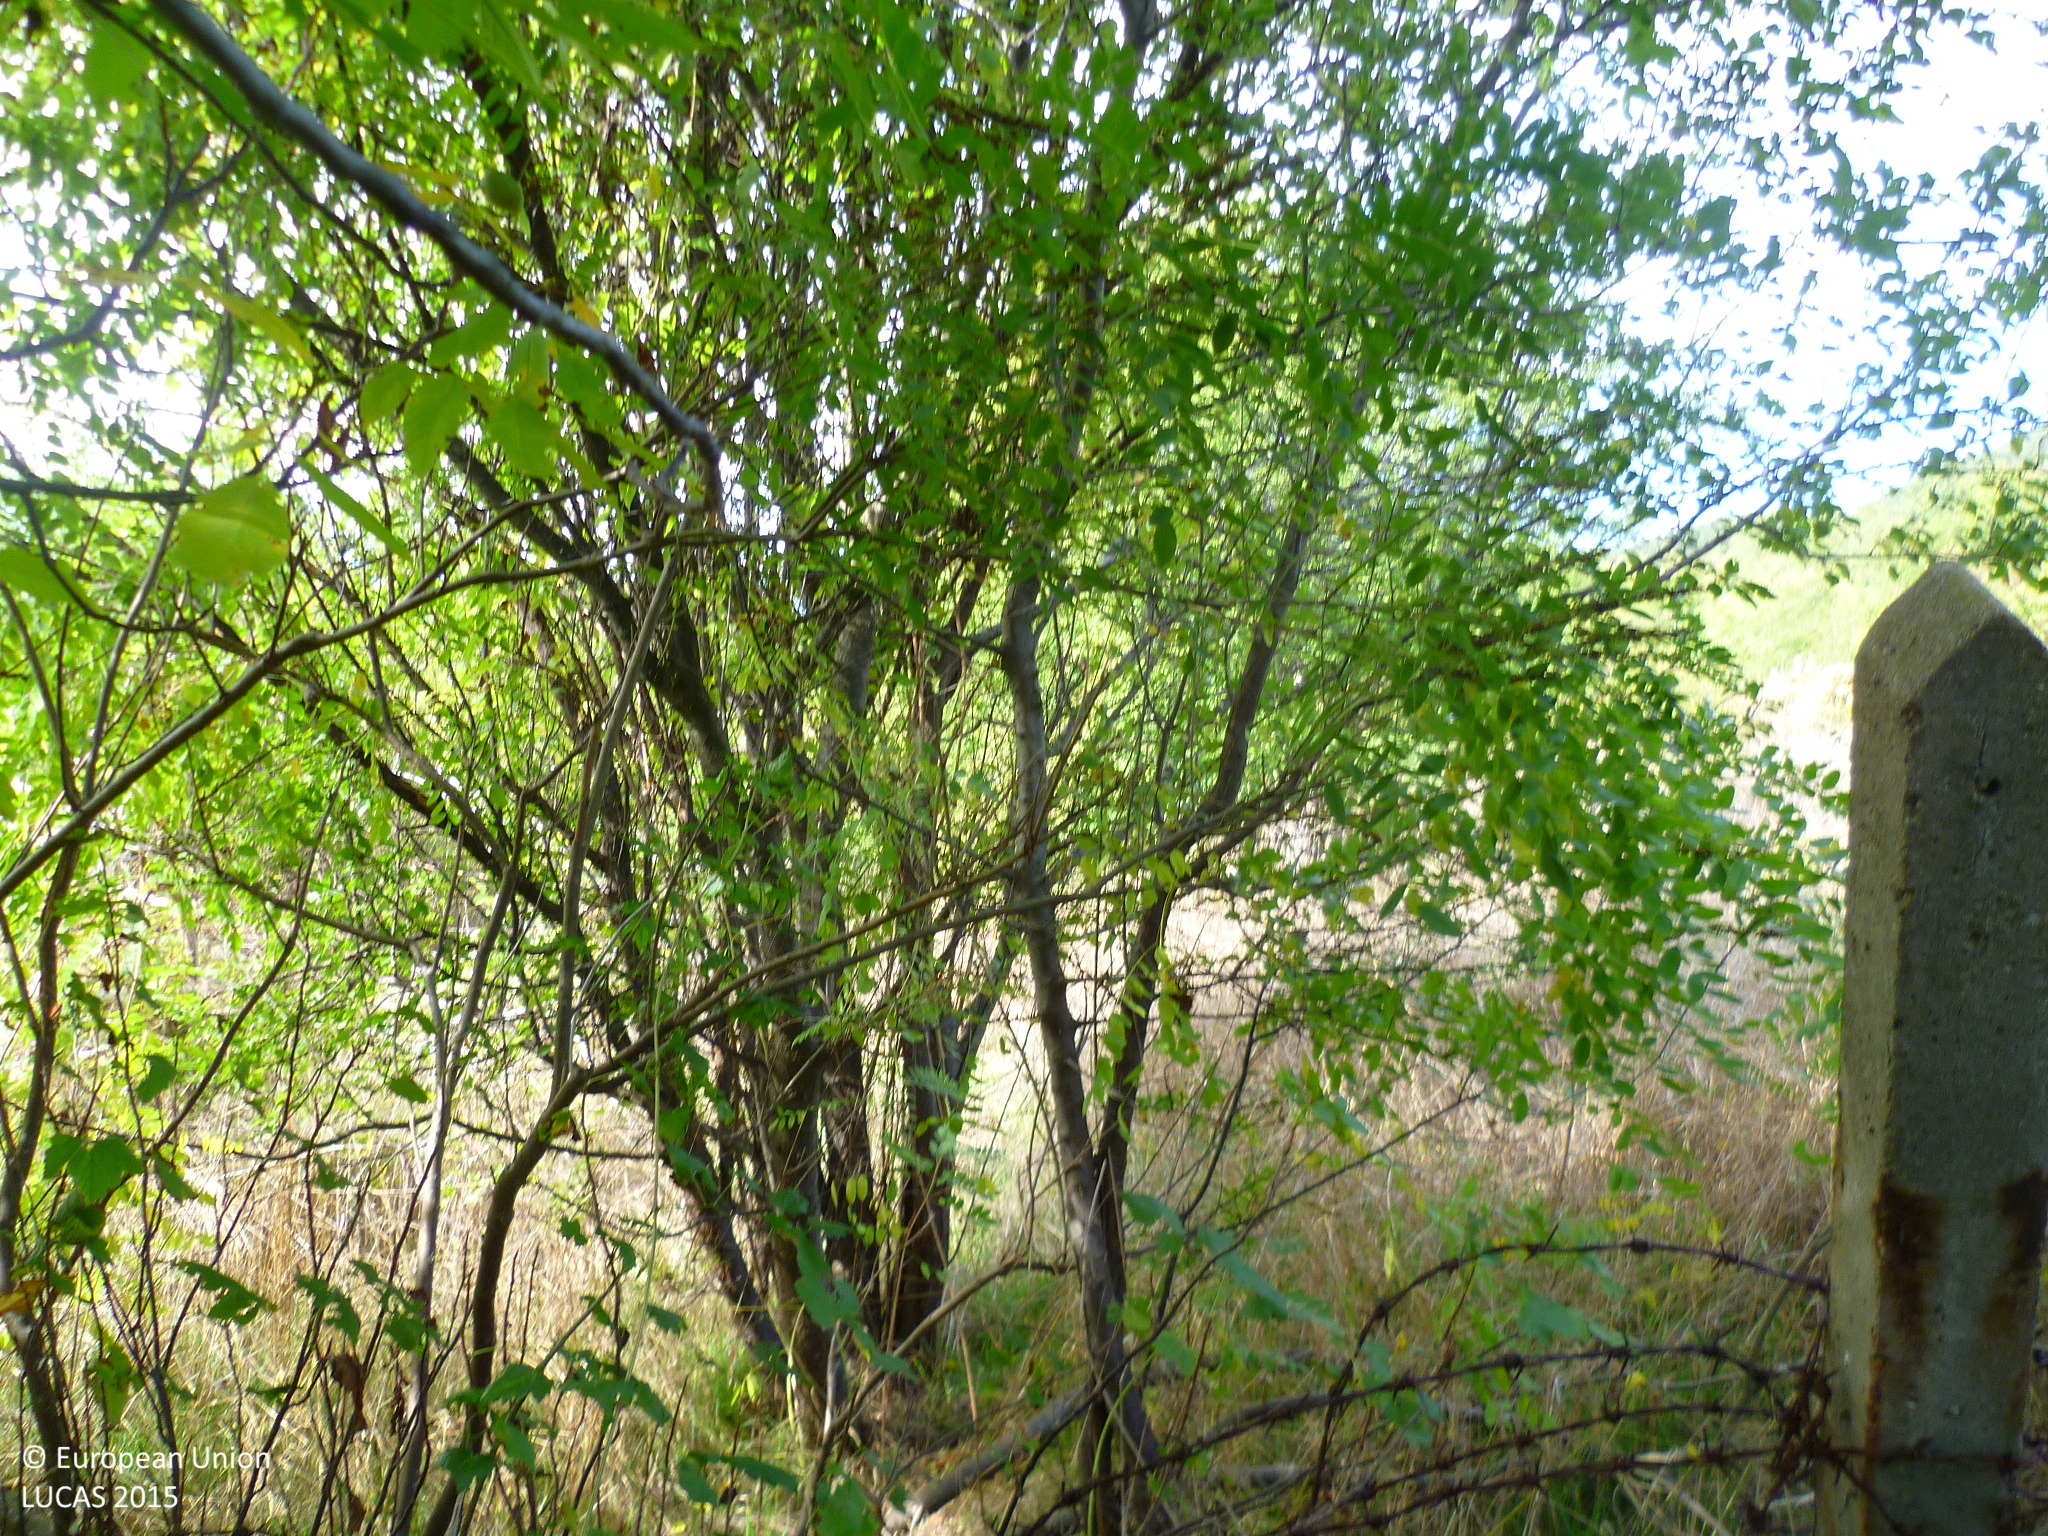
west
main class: Cropland
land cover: Nuts trees
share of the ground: 25 - 50 %
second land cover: Spontaneously vegetated surfaces
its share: 50 - 75 %
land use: Kitchen garden
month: October
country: BG
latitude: 42.8376
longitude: 22.8385
